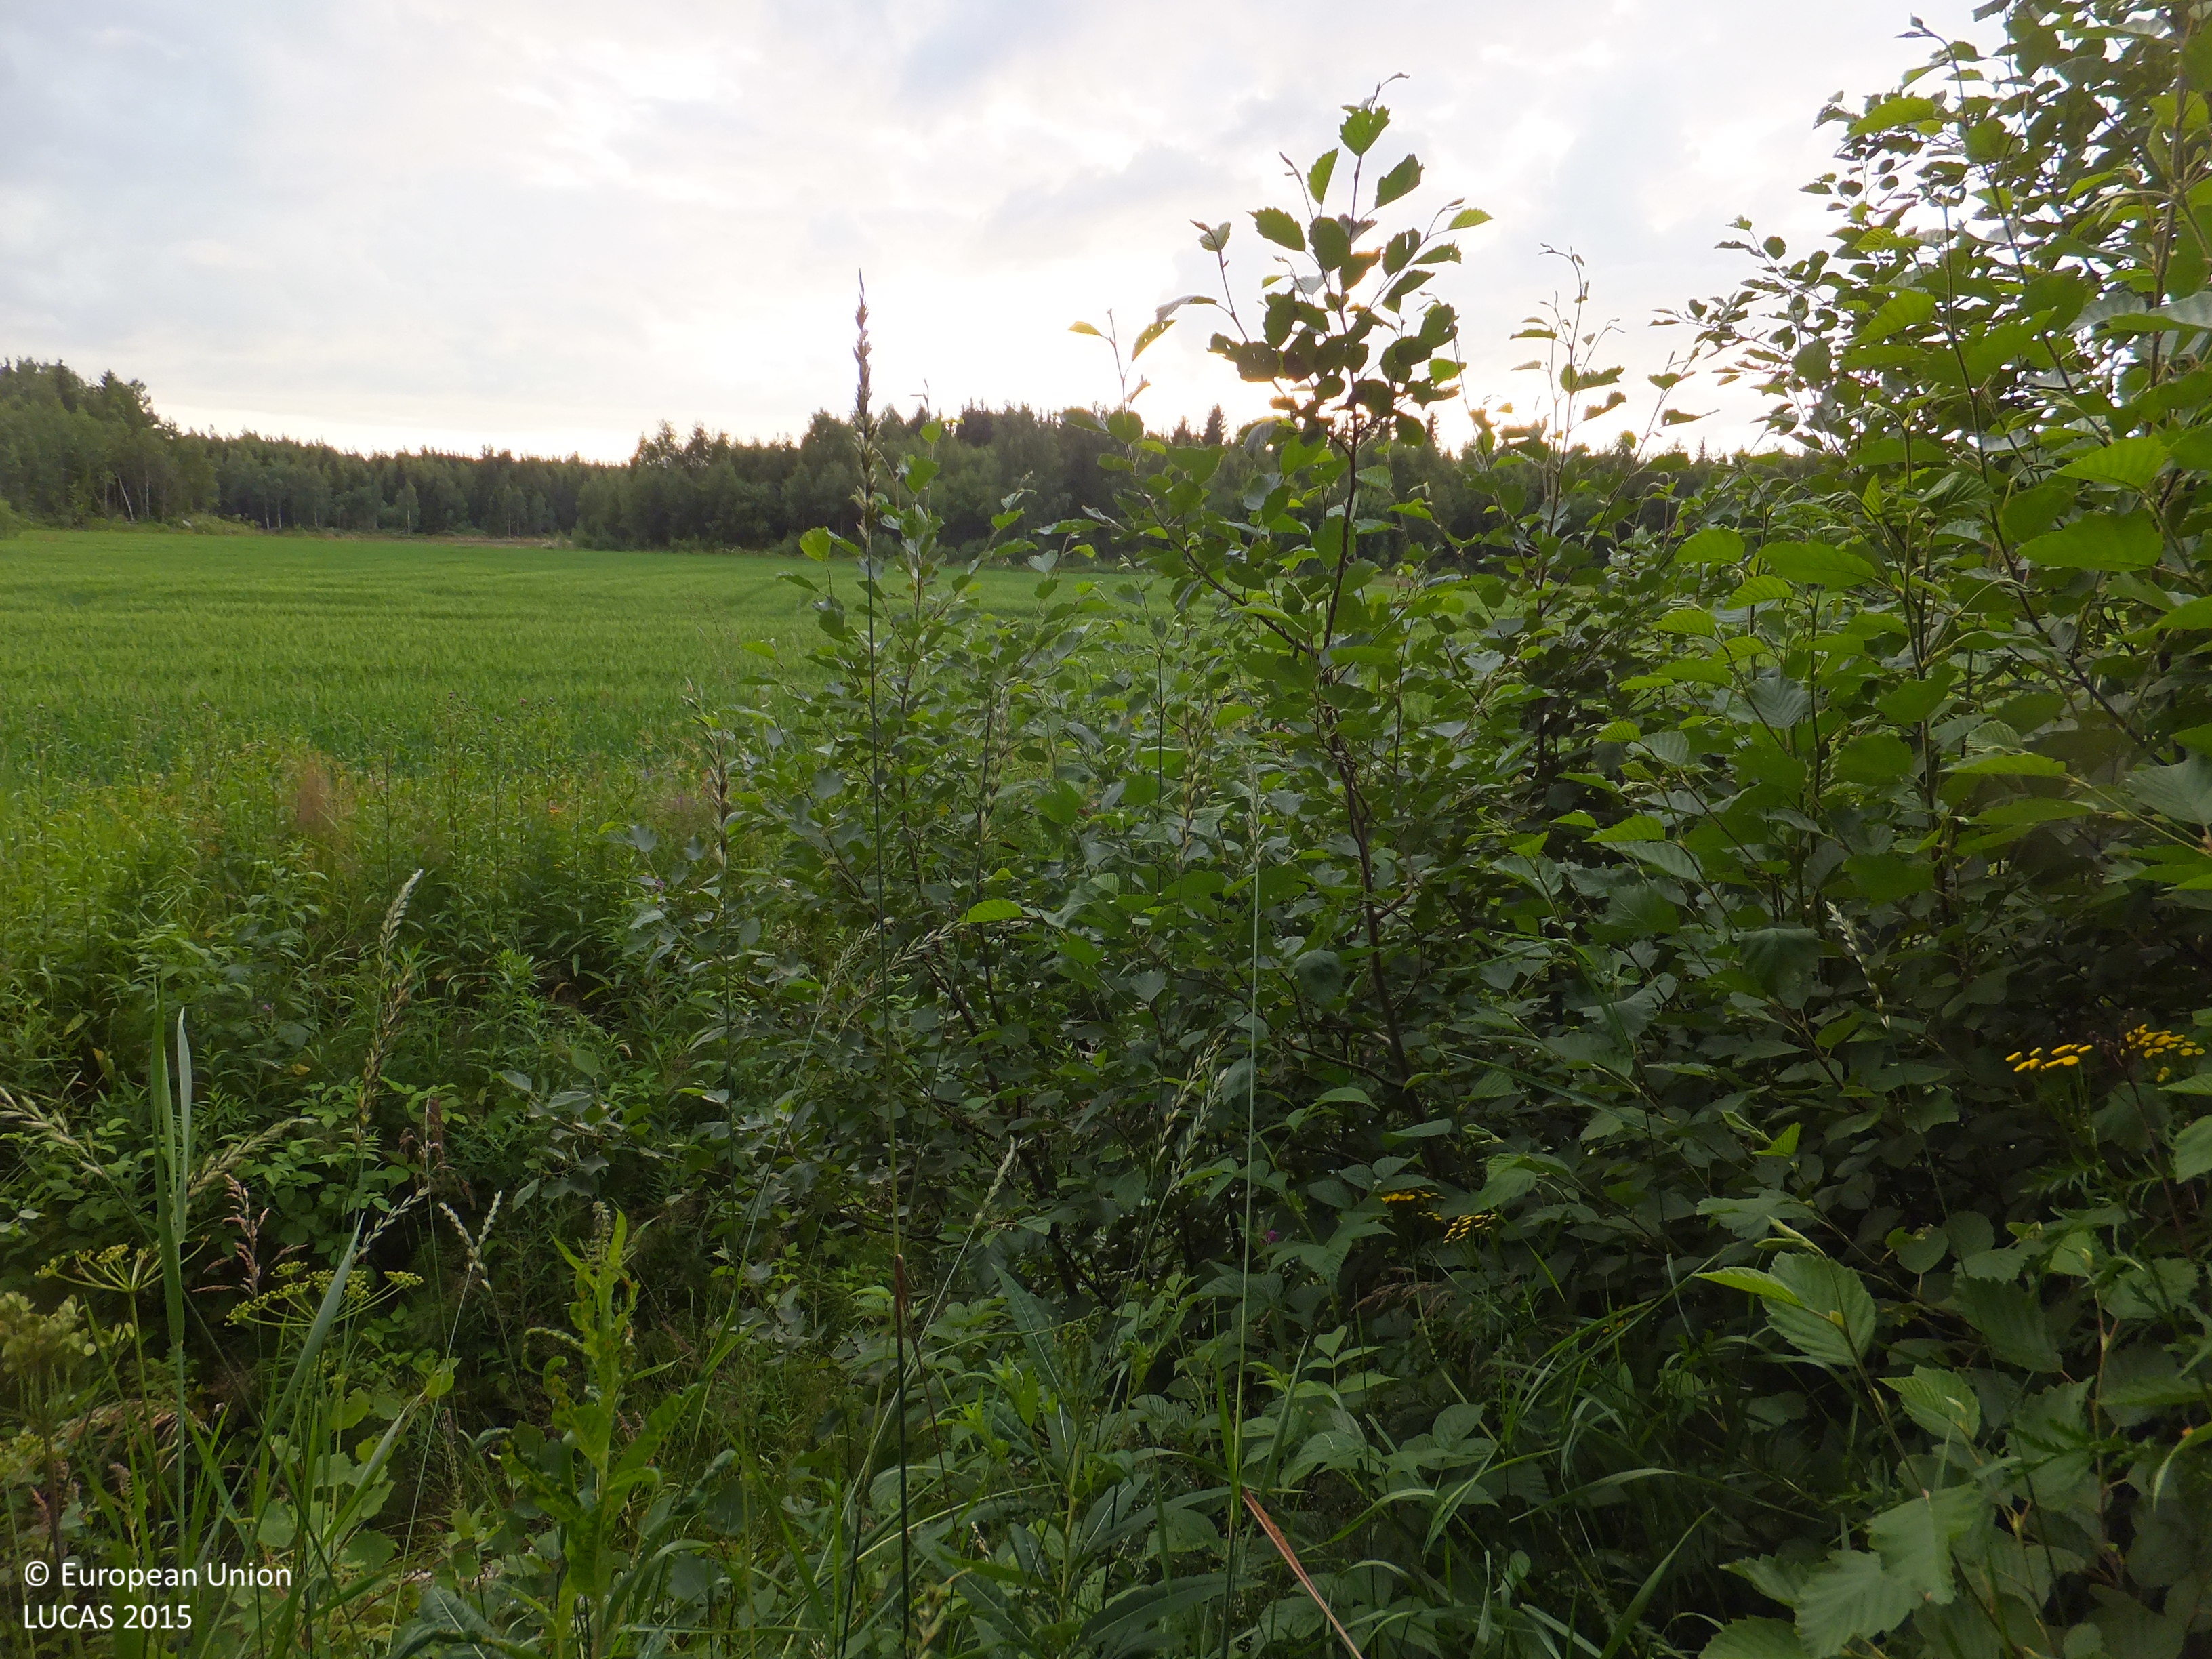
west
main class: Woodland
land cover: Broadleaved woodland
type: boreal forest
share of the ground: > 75 %
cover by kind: broadleaved forest trees 60 %, herbaceous plants 25 %, shrubs 15 %
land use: Forestry
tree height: > 5 m
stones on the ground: < 10 %
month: July
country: FI
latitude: 63.0917
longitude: 21.8669
